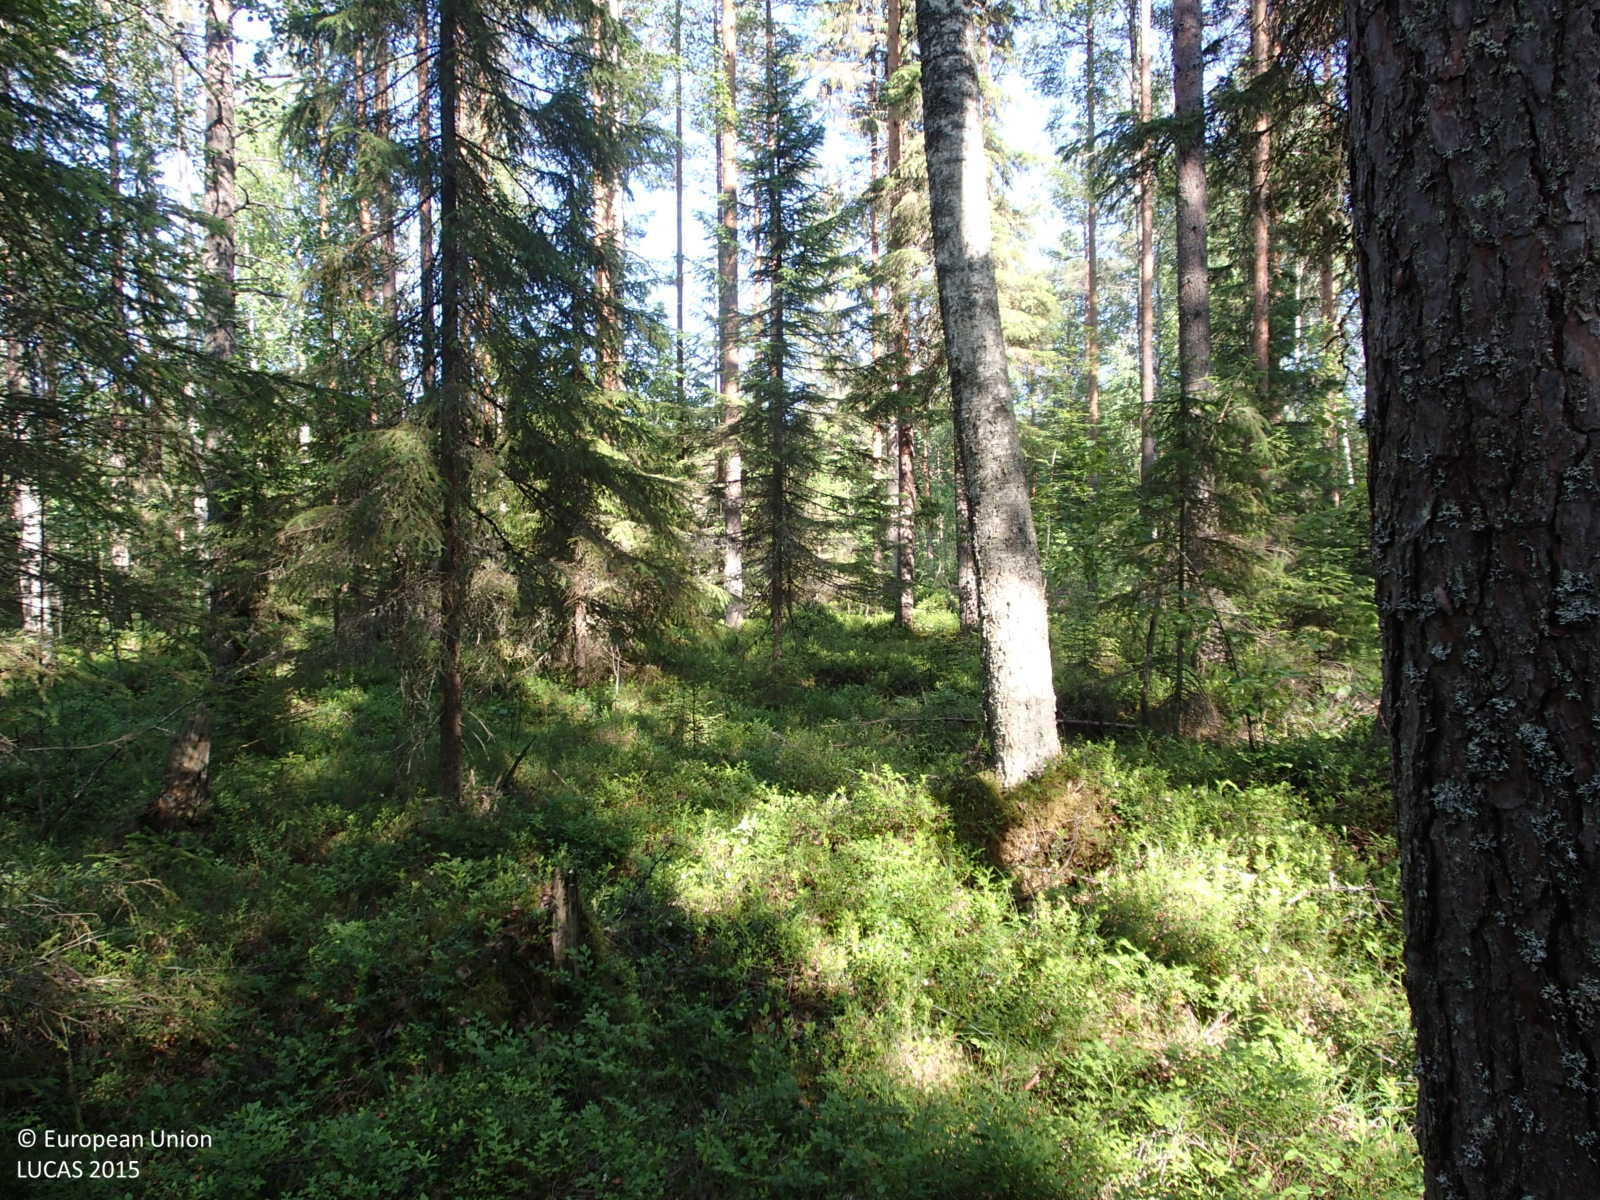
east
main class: Woodland
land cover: Other mixed woodland
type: boreal forest
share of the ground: > 75 %
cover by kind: coniferous forest trees 60 %, broadleaved forest trees 20 %, shrubs 20 %
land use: Forestry
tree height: > 5 m
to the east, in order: Other mixed woodland; Pine dominated mixed woodland; Ditches and canals; Pine dominated mixed woodland; Tracks; Pine dominated mixed woodland; Ditches and canals; Pine dominated coniferous woodland; Ditches and canals; Pine dominated mixed woodland; Ditches and canals; Pine dominated mixed woodland; Pine dominated coniferous woodland; Other bare soil
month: July
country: FI
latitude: 64.1166
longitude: 27.2007
